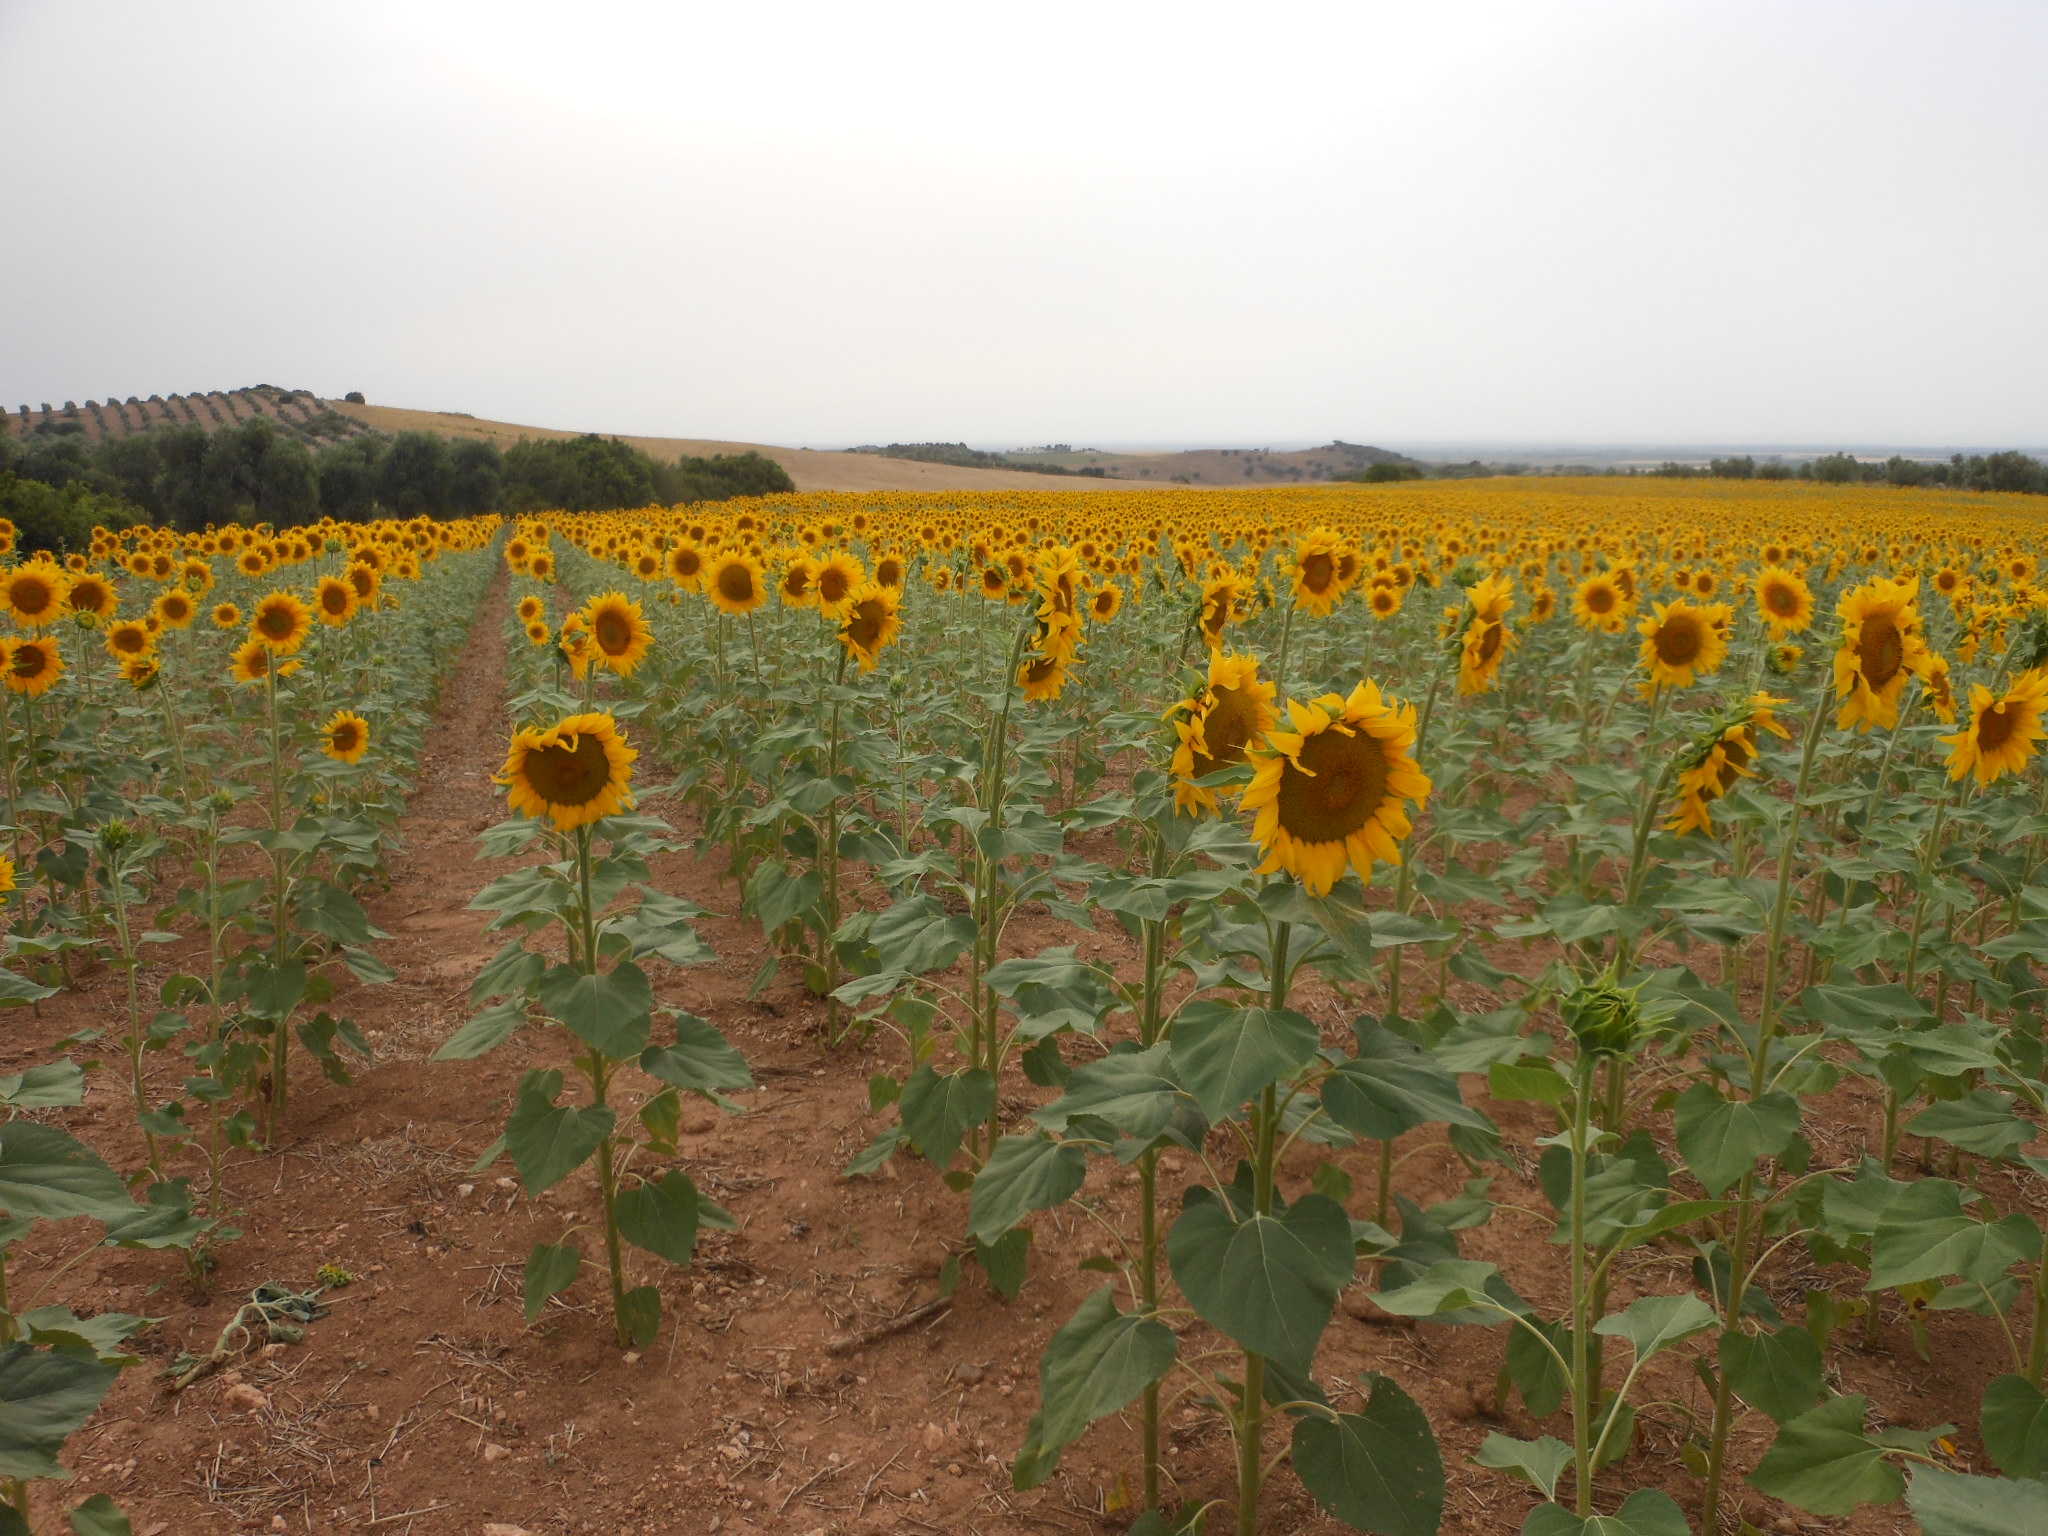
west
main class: Cropland
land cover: Sunflower
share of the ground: > 75 %
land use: Agriculture (excluding fallow land and kitchen gardens)
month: June
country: ES
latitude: 37.1765
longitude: -5.3388
